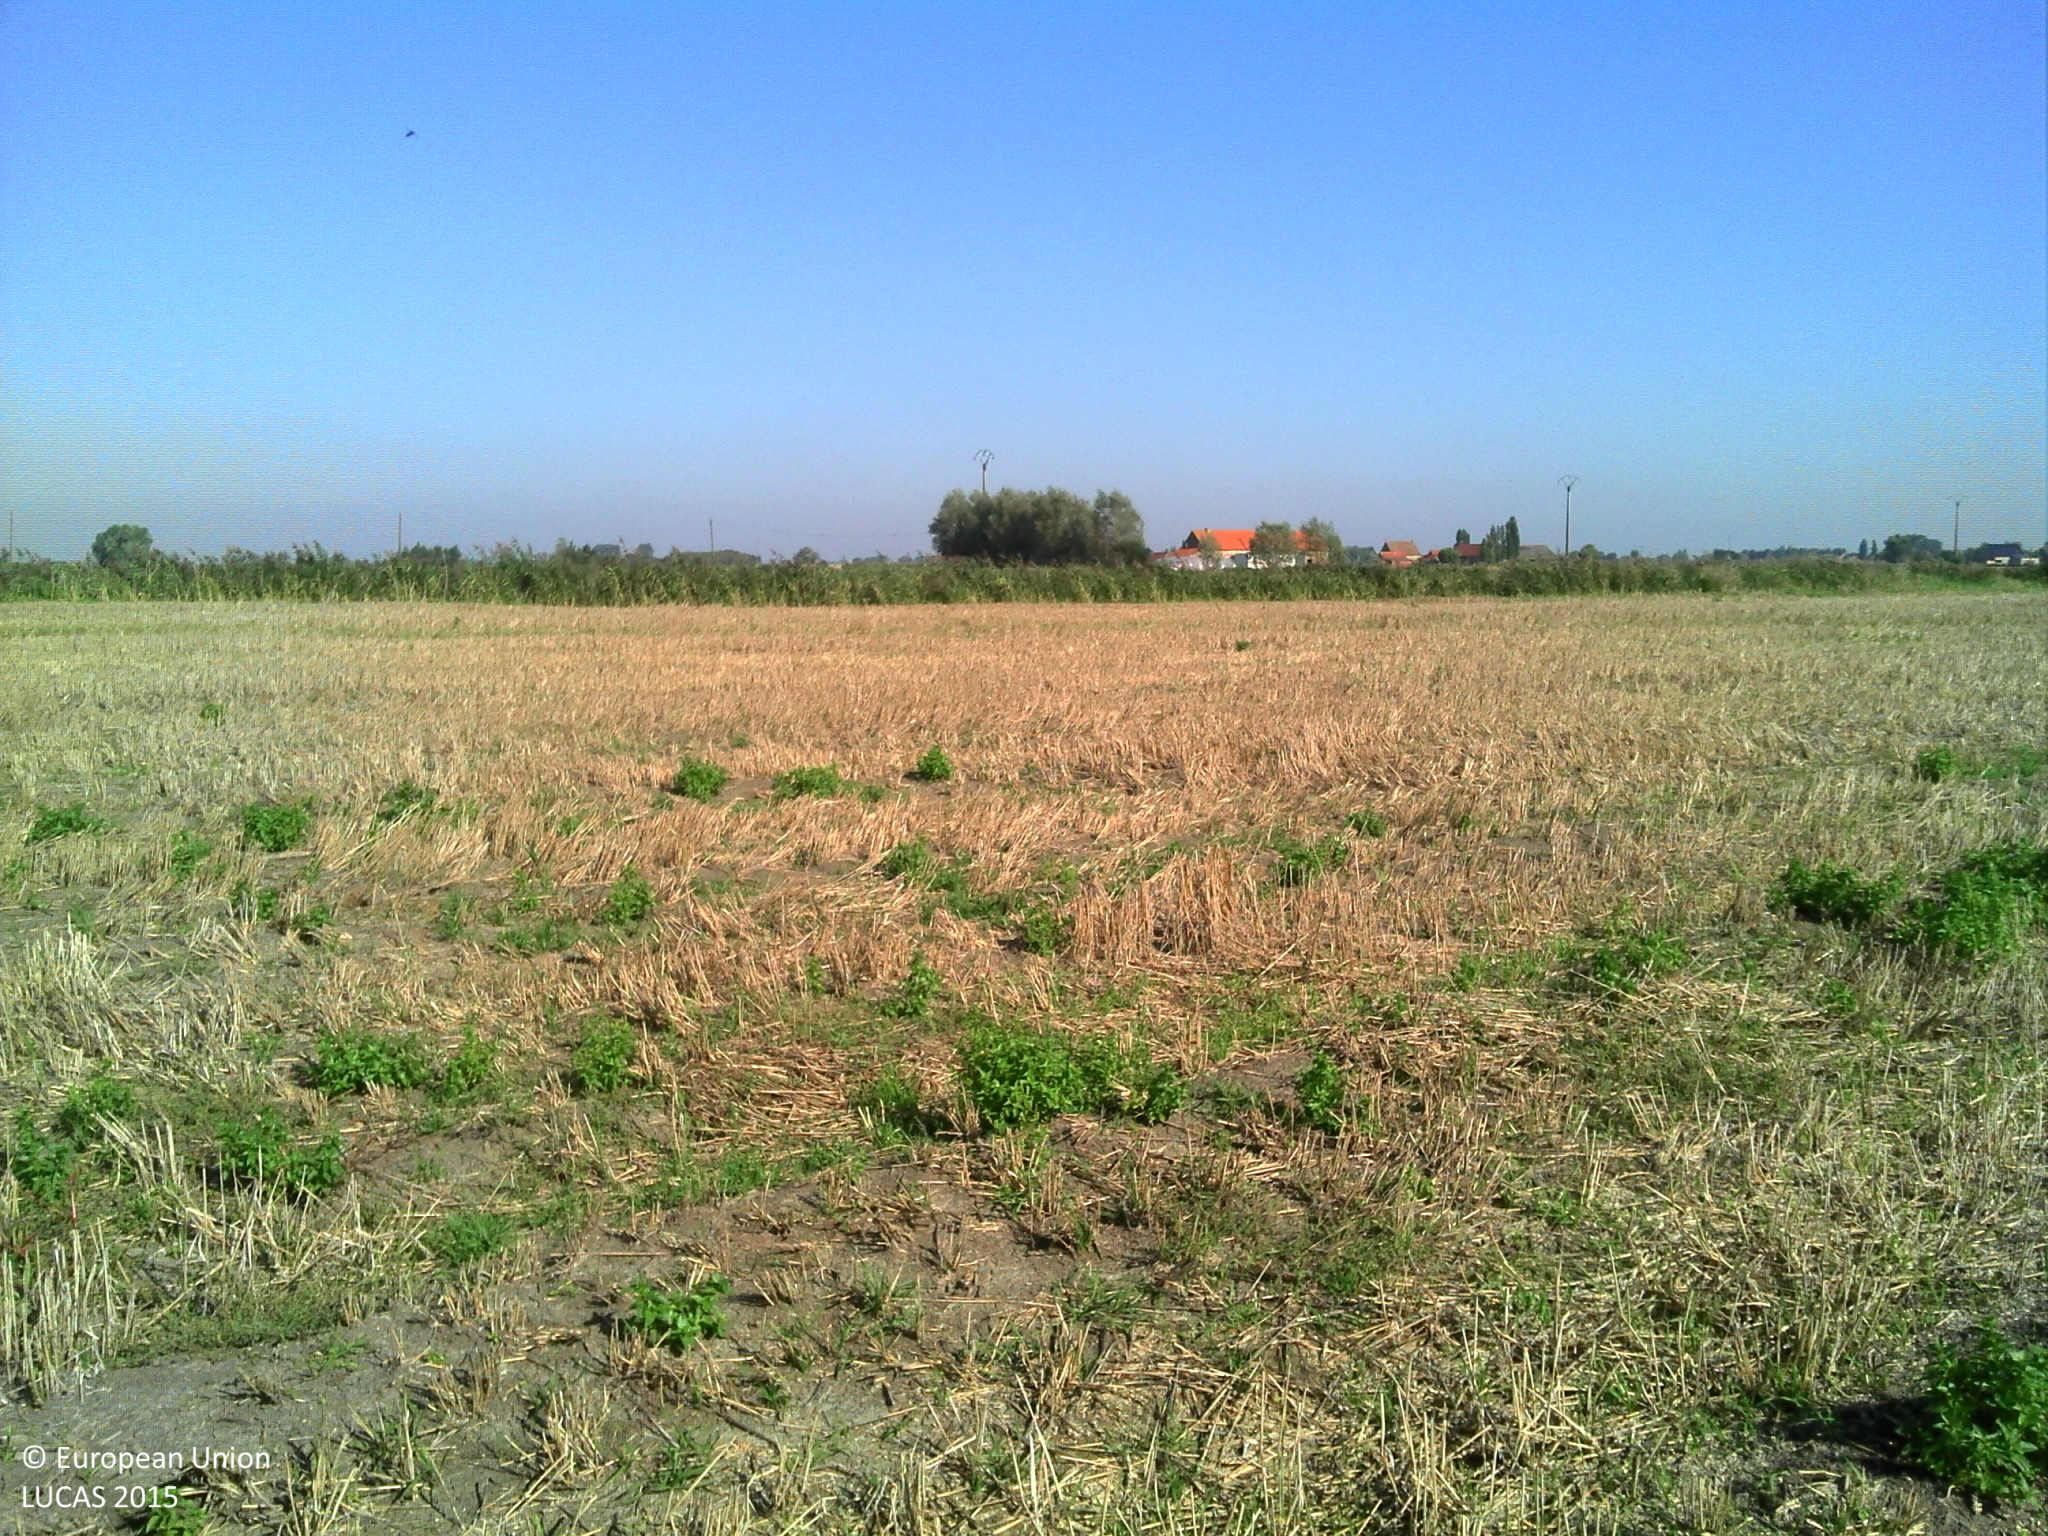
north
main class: Cropland
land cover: Common wheat
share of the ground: 25 - 50 %
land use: Agriculture (excluding fallow land and kitchen gardens)
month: September
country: BE
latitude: 51.0388
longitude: 2.7866
